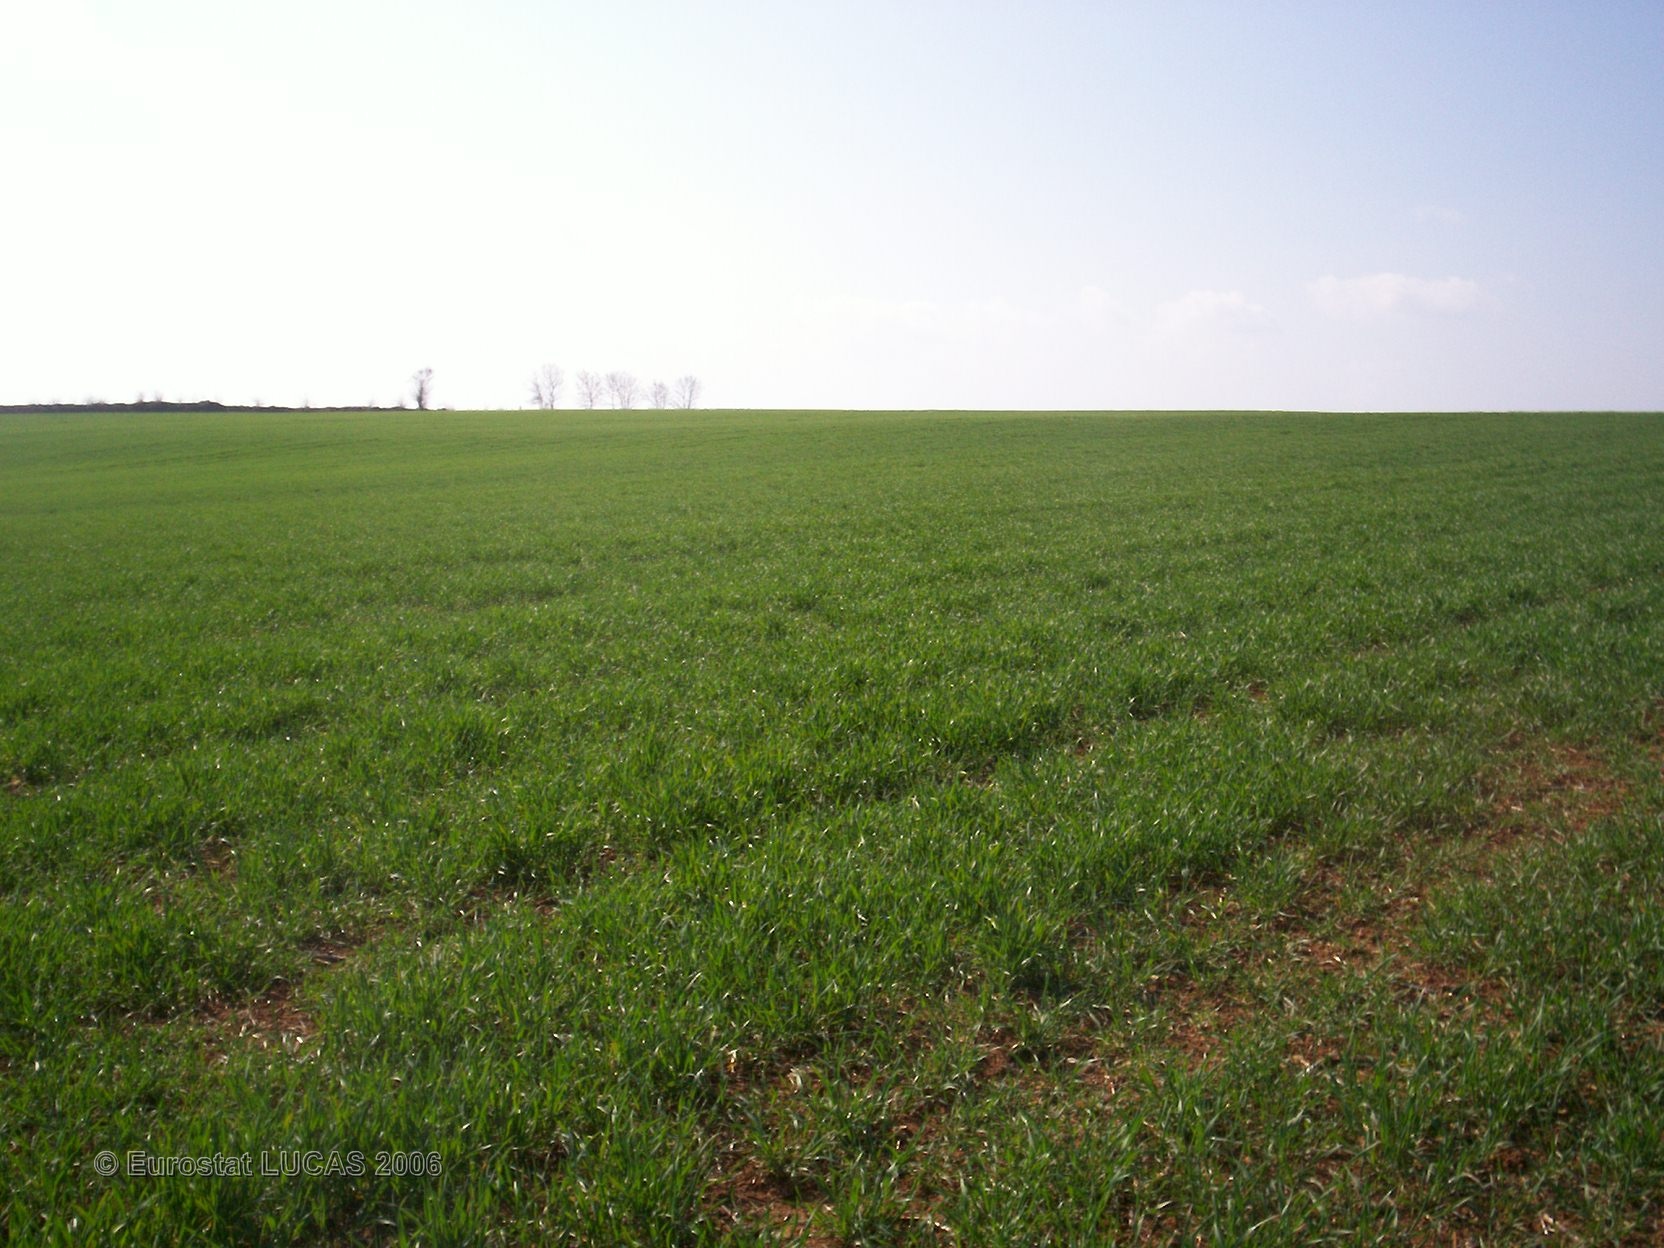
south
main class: Cropland
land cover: Common wheat
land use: Agriculture (excluding fallow land and kitchen gardens)
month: April
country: FR
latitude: 47.4394
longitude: 4.5495
